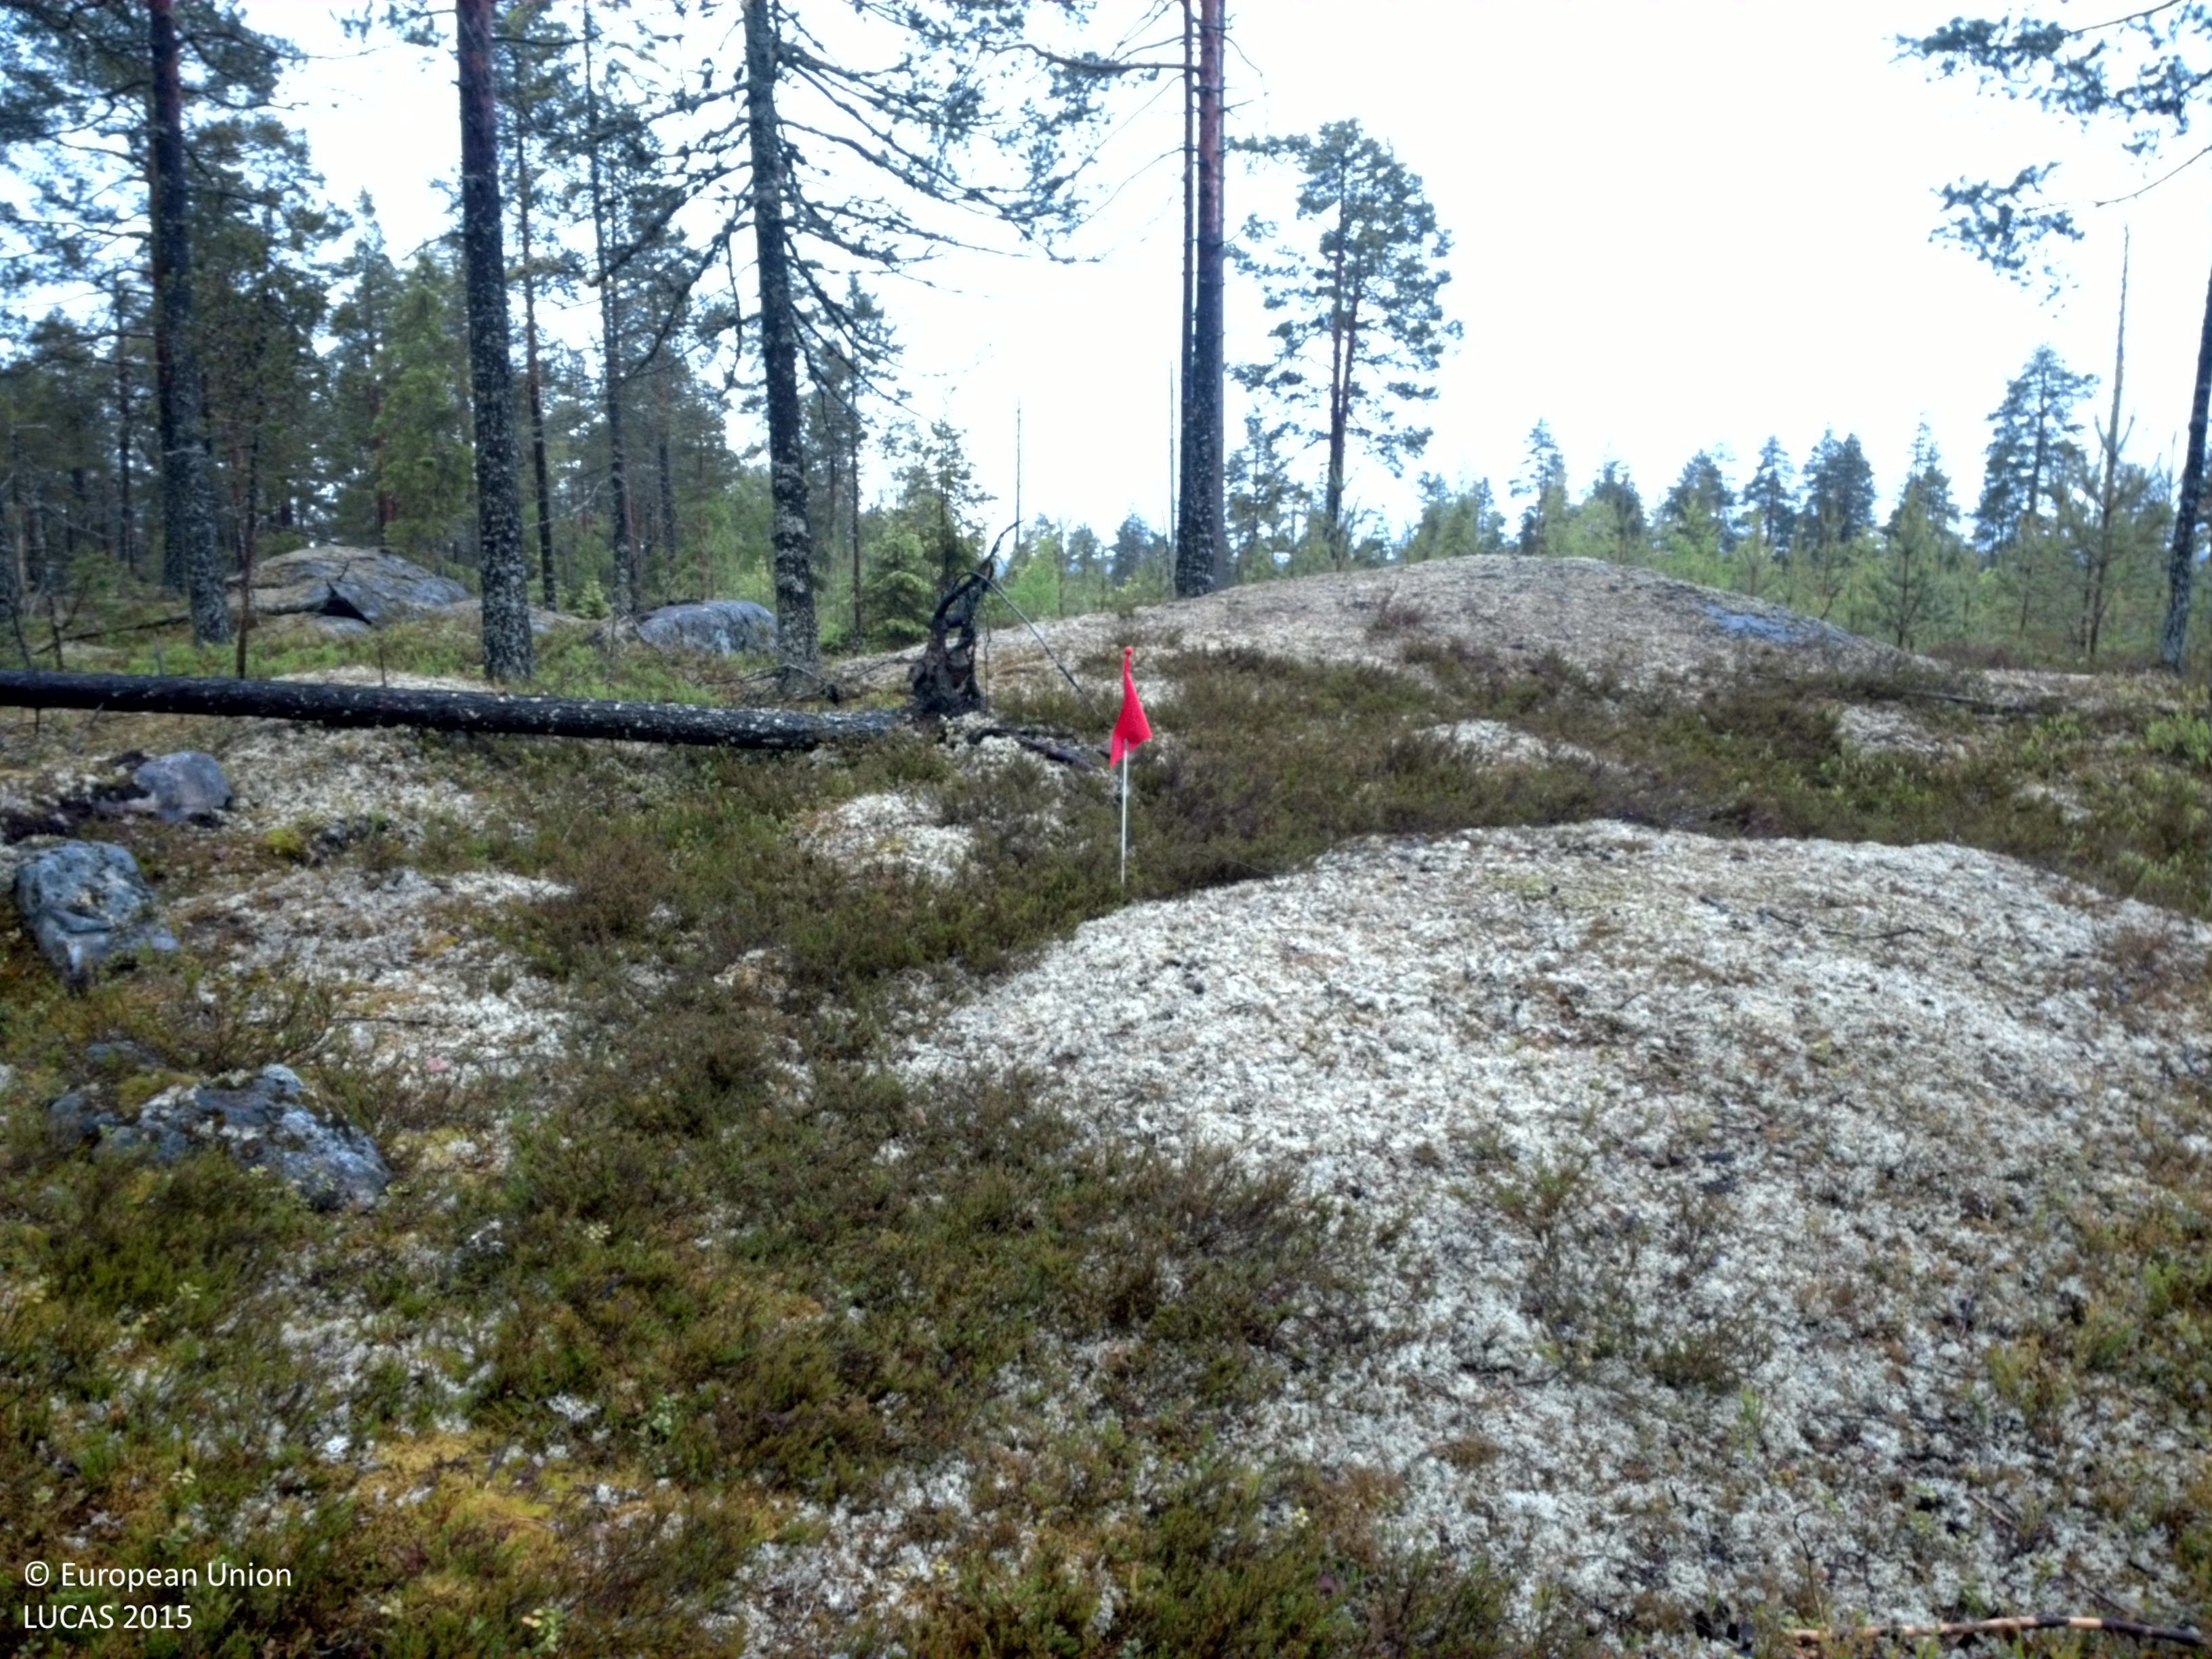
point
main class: Woodland
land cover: Pine dominated coniferous woodland
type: boreal forest
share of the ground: 25 - 50 %
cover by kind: shrubs 40 %, coniferous forest trees 35 %, lichens and mosses 20 %, consolidated bare surface 5 %
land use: Forestry
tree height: > 5 m
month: June
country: SE
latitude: 64.3155
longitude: 20.8797
